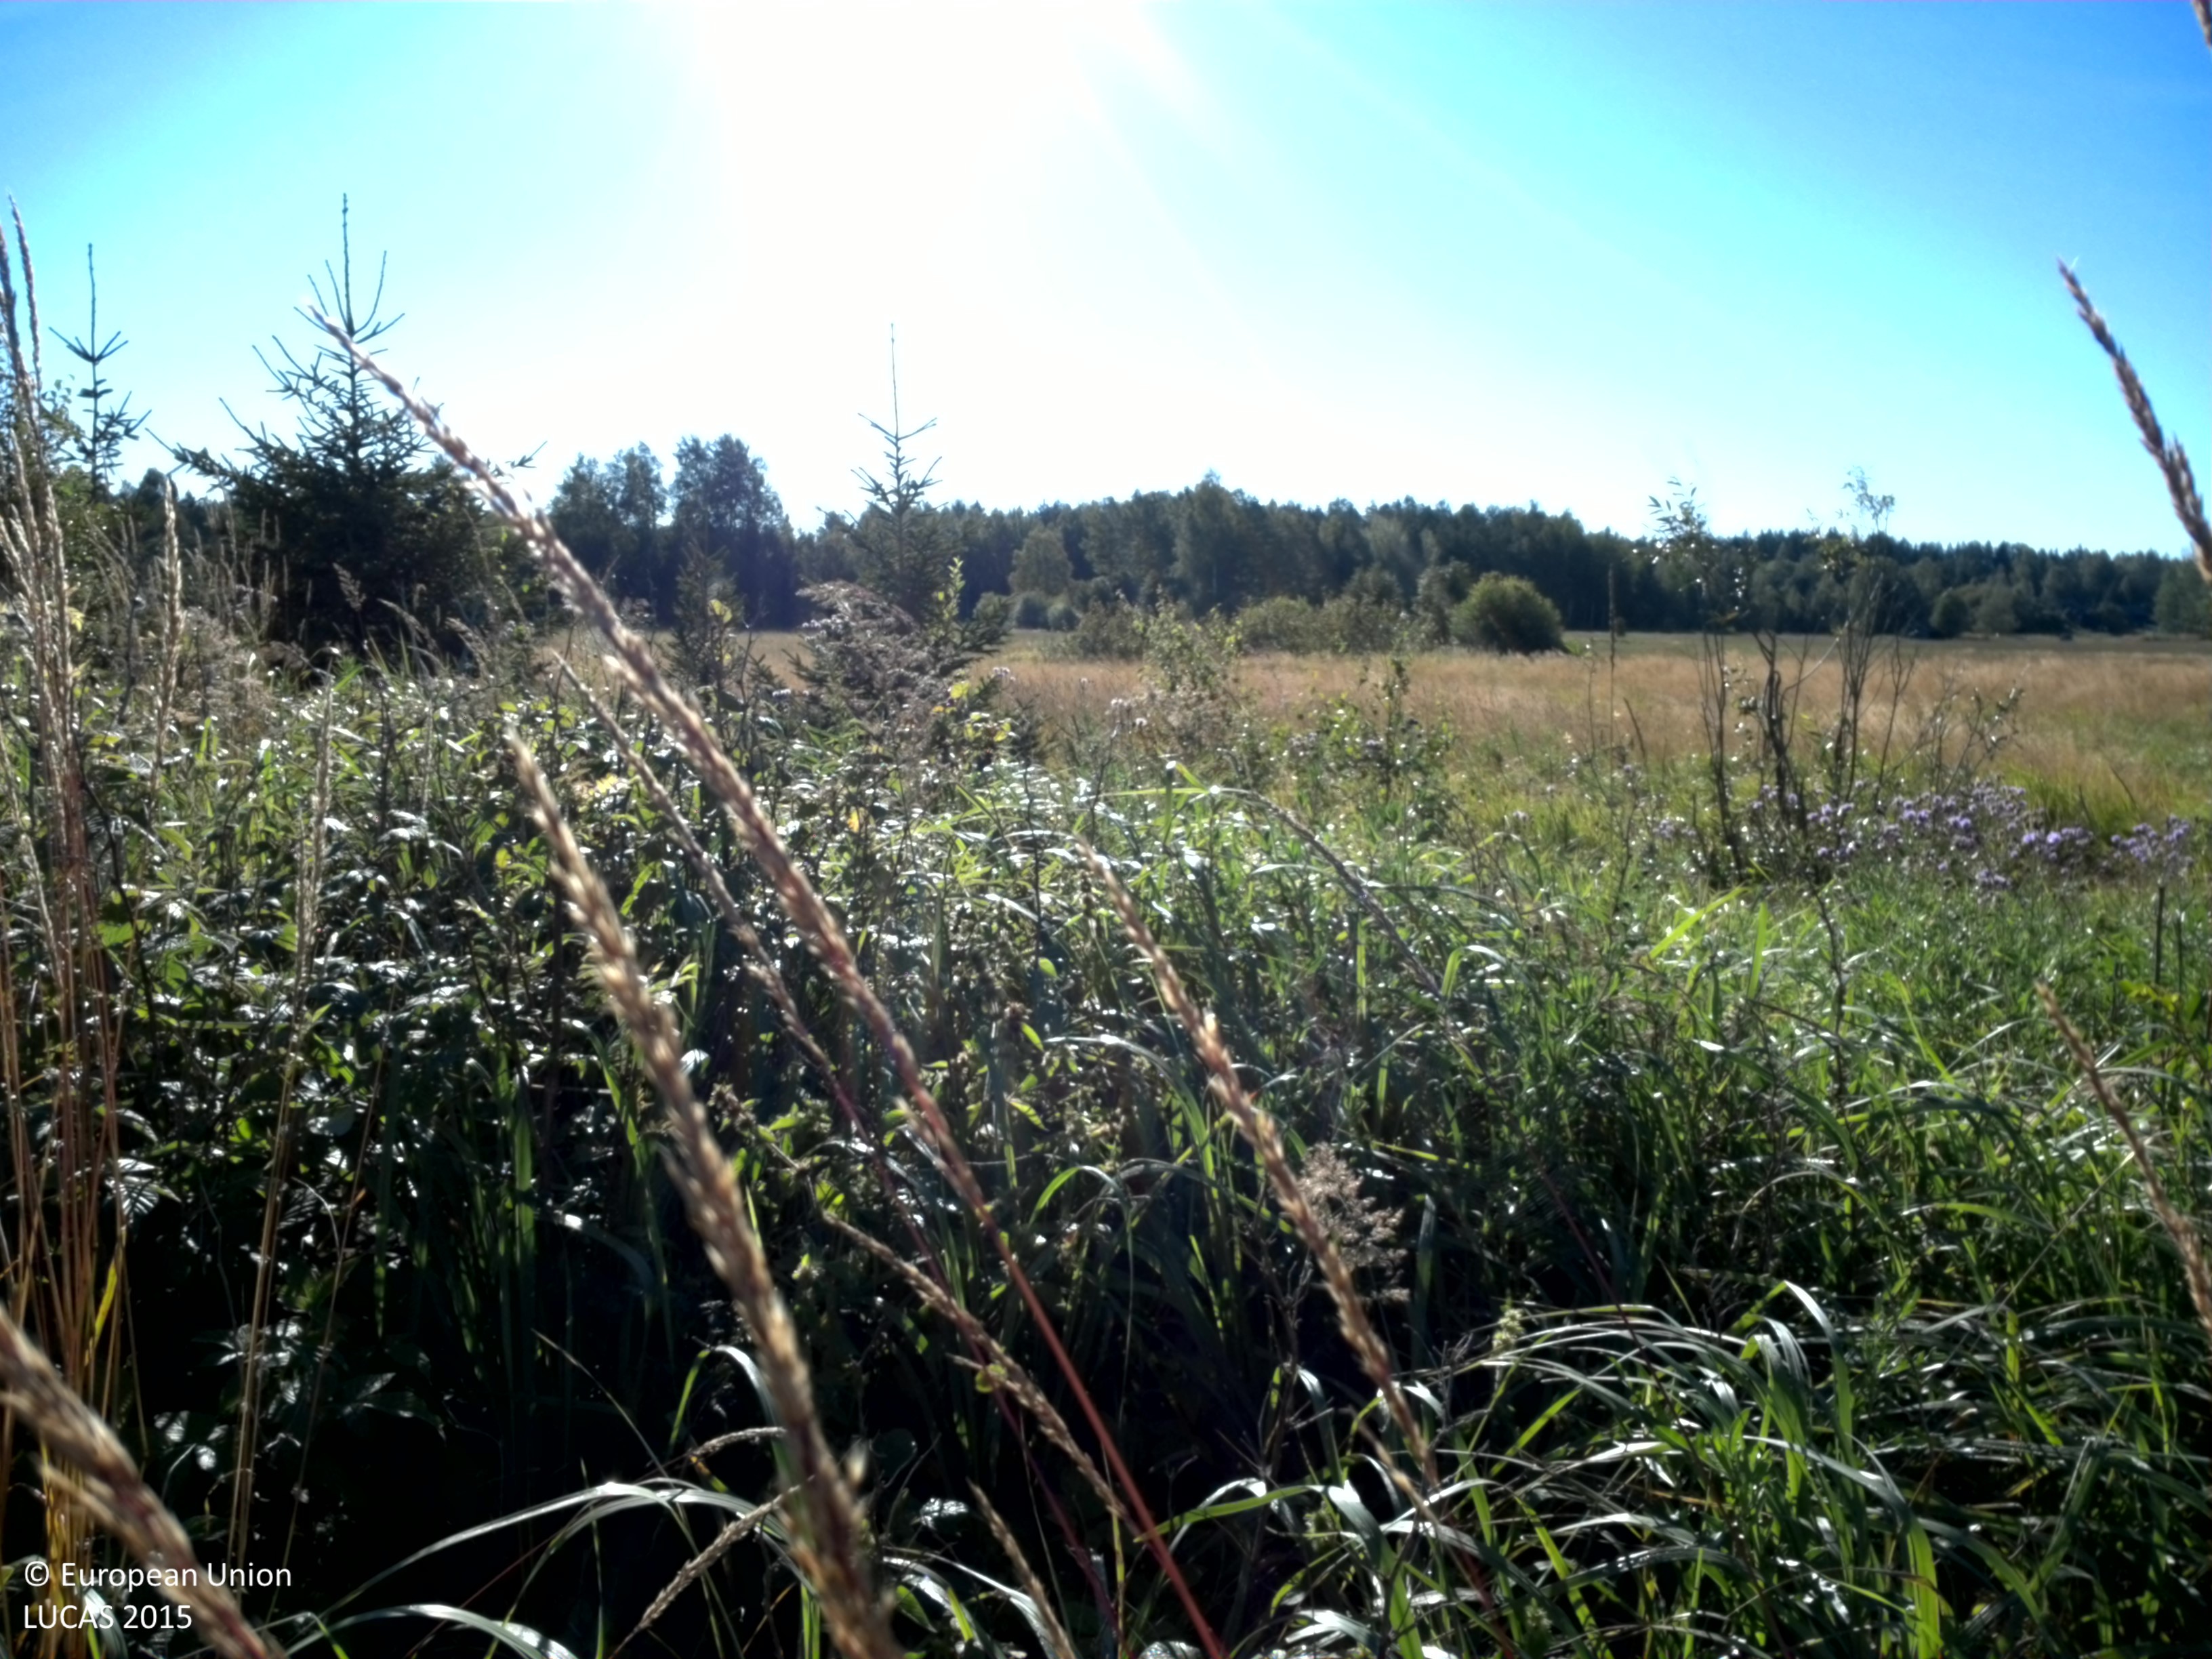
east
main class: Grassland
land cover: Grassland without tree/shrub cover
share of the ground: > 75 %
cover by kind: herbaceous plants 100 %
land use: Forestry
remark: Clear cut
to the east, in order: Grassland without tree/shrub cover; Ditches and canals; Other leguminous and mixtures for fodder; Grass margins; Tracks; Other leguminous and mixtures for fodder; Ditches and canals; Other leguminous and mixtures for fodder; Broadleaved woodland; Other leguminous and mixtures for fodder
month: August
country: SE
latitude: 60.1104
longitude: 17.0976
